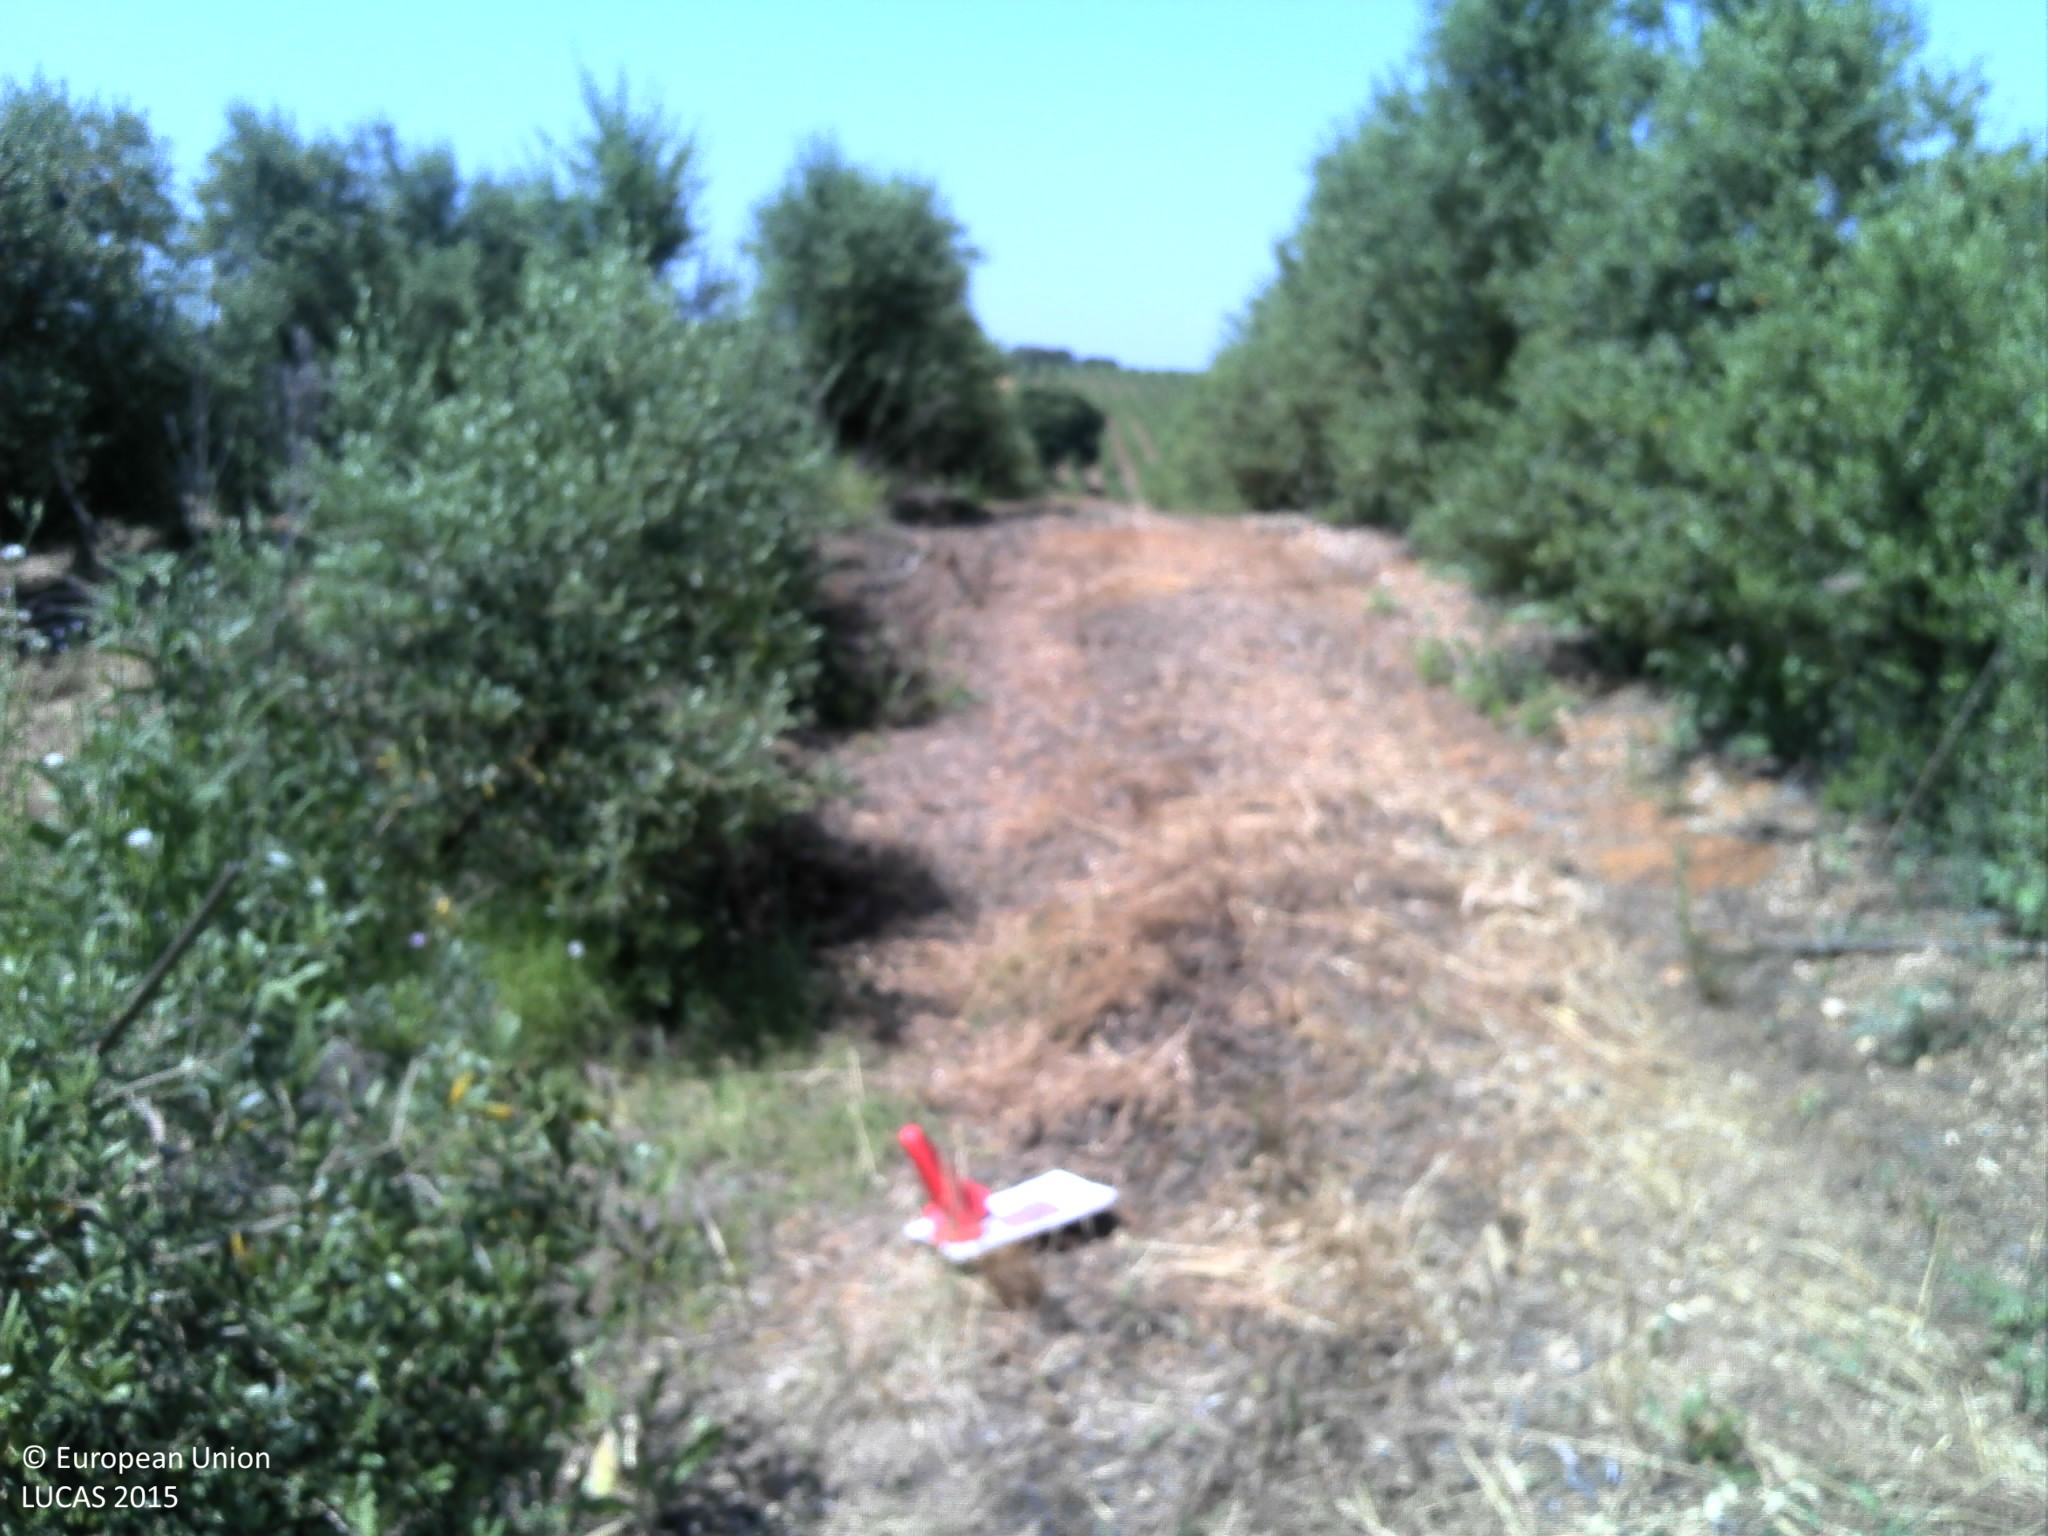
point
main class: Cropland
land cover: Olive groves
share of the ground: 25 - 50 %
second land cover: Spontaneously vegetated surfaces
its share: 10 - 25 %
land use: Agriculture (excluding fallow land and kitchen gardens)
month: June
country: PT
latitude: 37.8762
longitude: -8.3286
